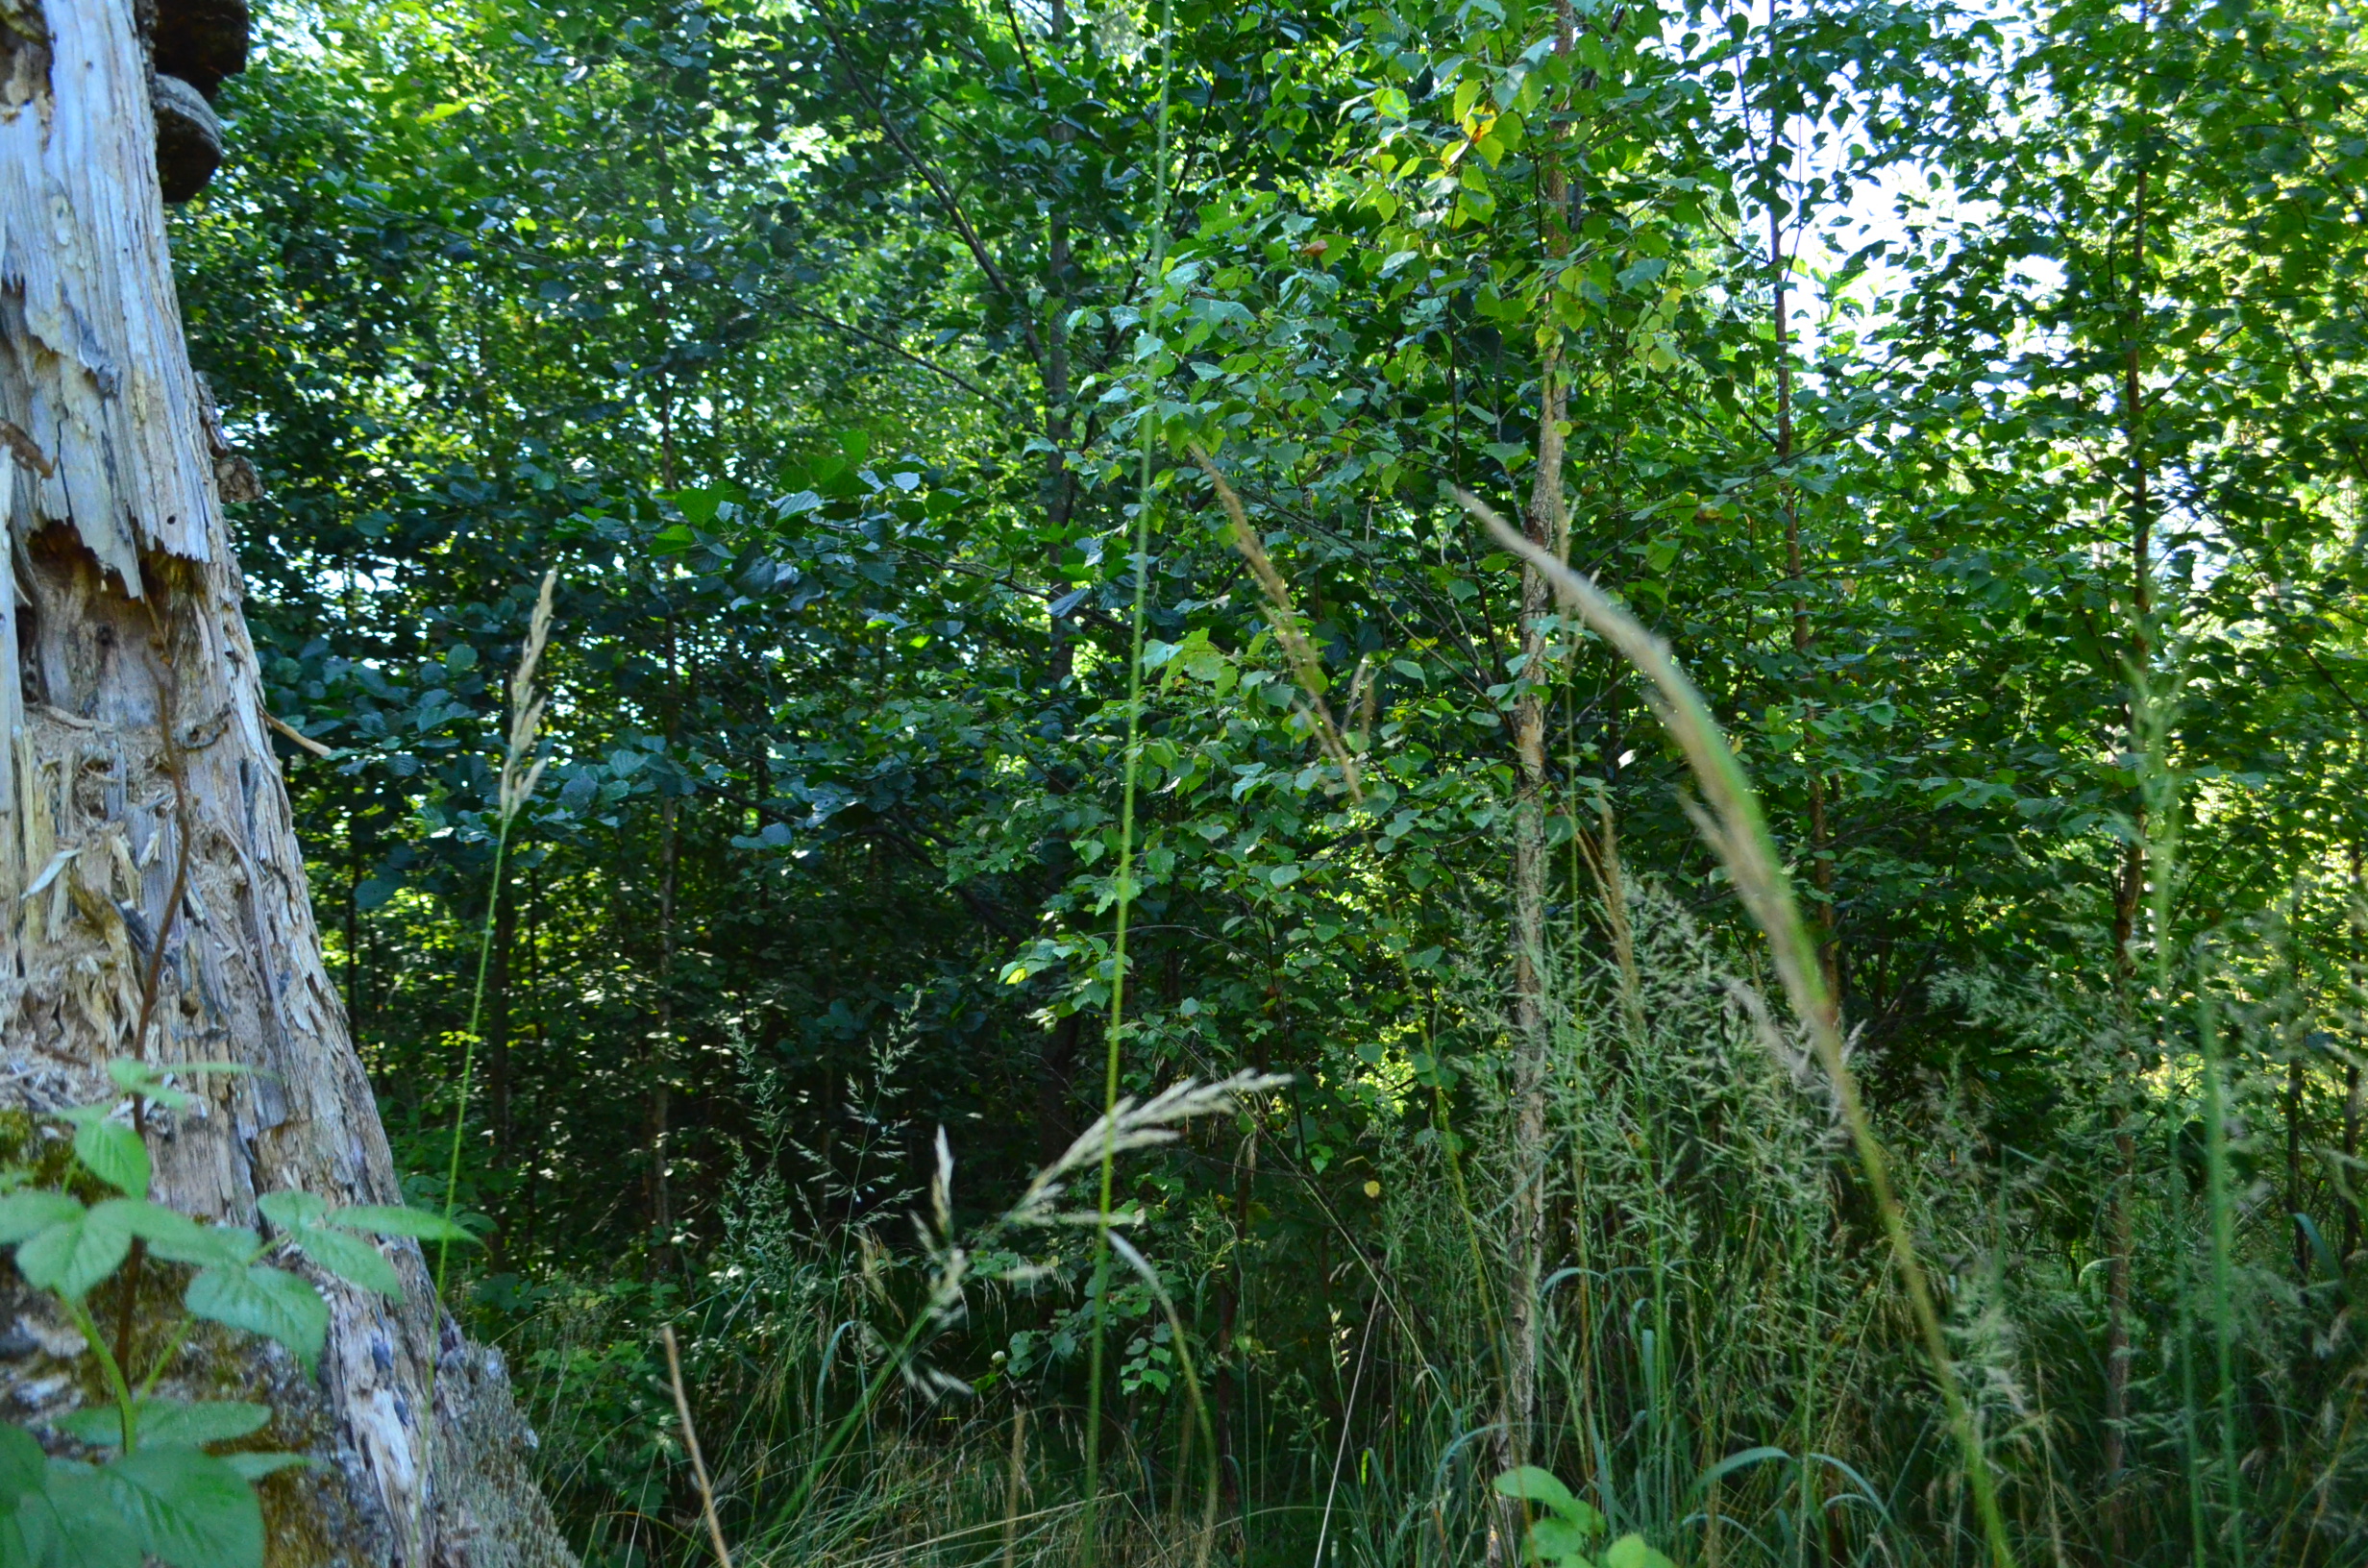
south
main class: Woodland
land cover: Spruce dominated mixed woodland
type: hemiboreal forest and nemoral coniferous forest and mixed broadleaved-coniferous forest
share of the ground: 50 - 75 %
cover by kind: broadleaved forest trees 30 %, shrubs 30 %, coniferous forest trees 25 %, herbaceous plants 15 %
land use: Forestry
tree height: < 5 m
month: August
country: LV
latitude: 57.3892
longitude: 22.3793
